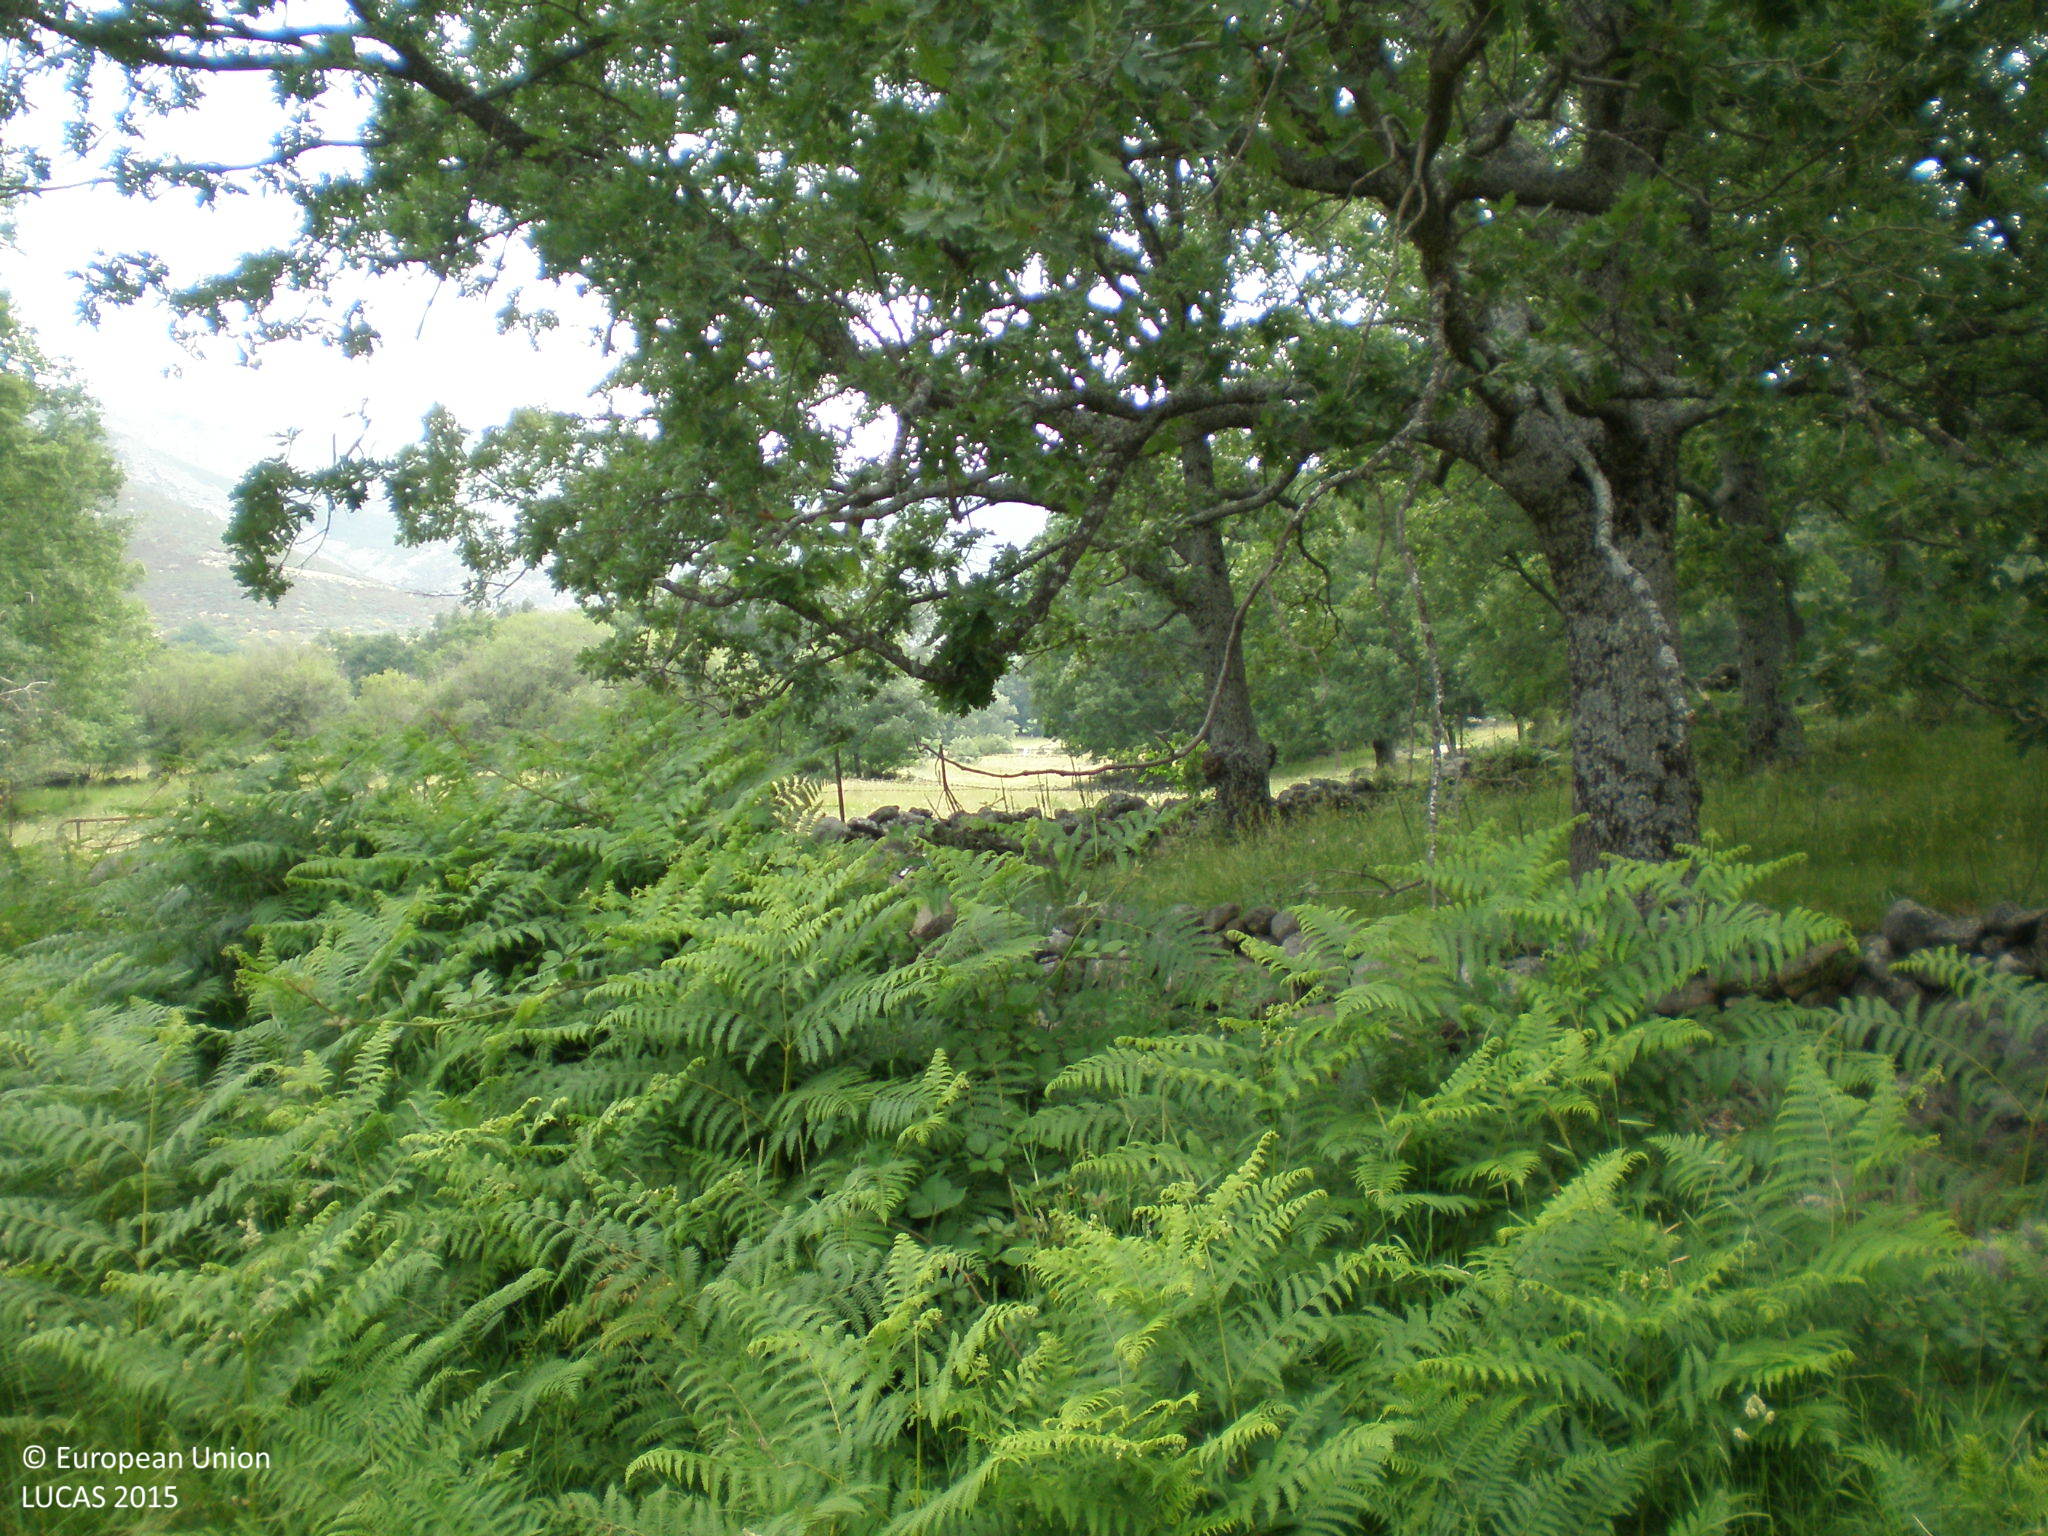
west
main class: Grassland
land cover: Grassland without tree/shrub cover
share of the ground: > 75 %
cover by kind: herbaceous plants 100 %
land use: Agriculture (excluding fallow land and kitchen gardens)
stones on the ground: < 10 %
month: June
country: ES
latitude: 40.2547
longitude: -5.5247
